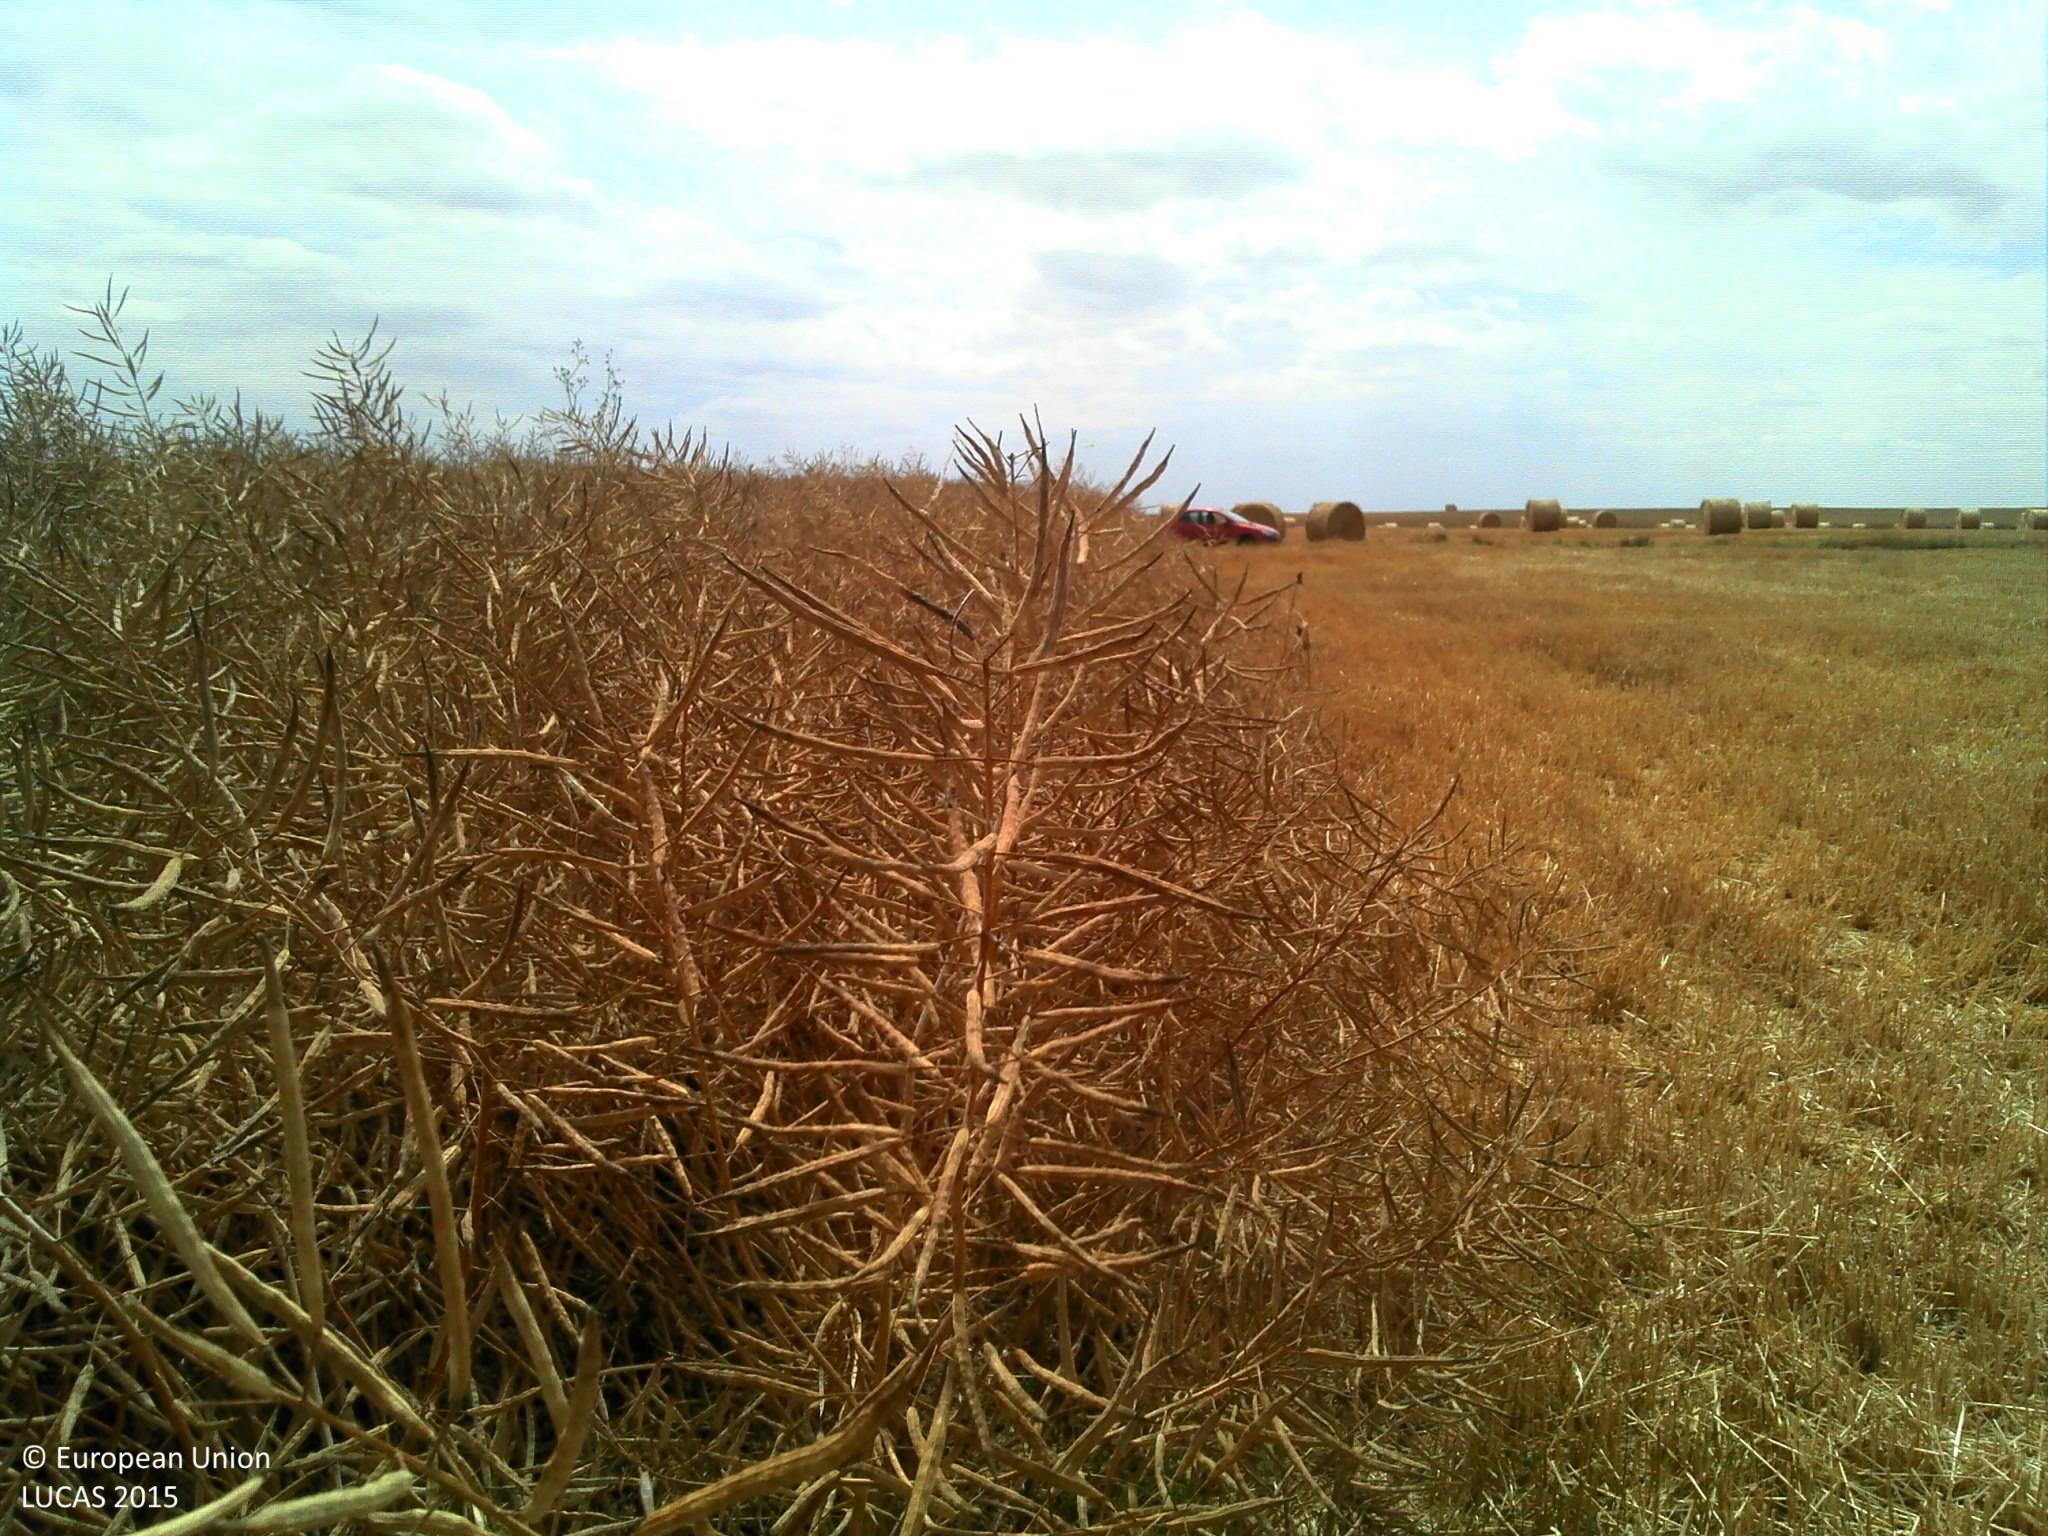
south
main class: Cropland
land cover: Rape and turnip rape
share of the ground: > 75 %
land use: Agriculture (excluding fallow land and kitchen gardens)
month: July
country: FR
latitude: 48.4707
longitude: 1.2300
